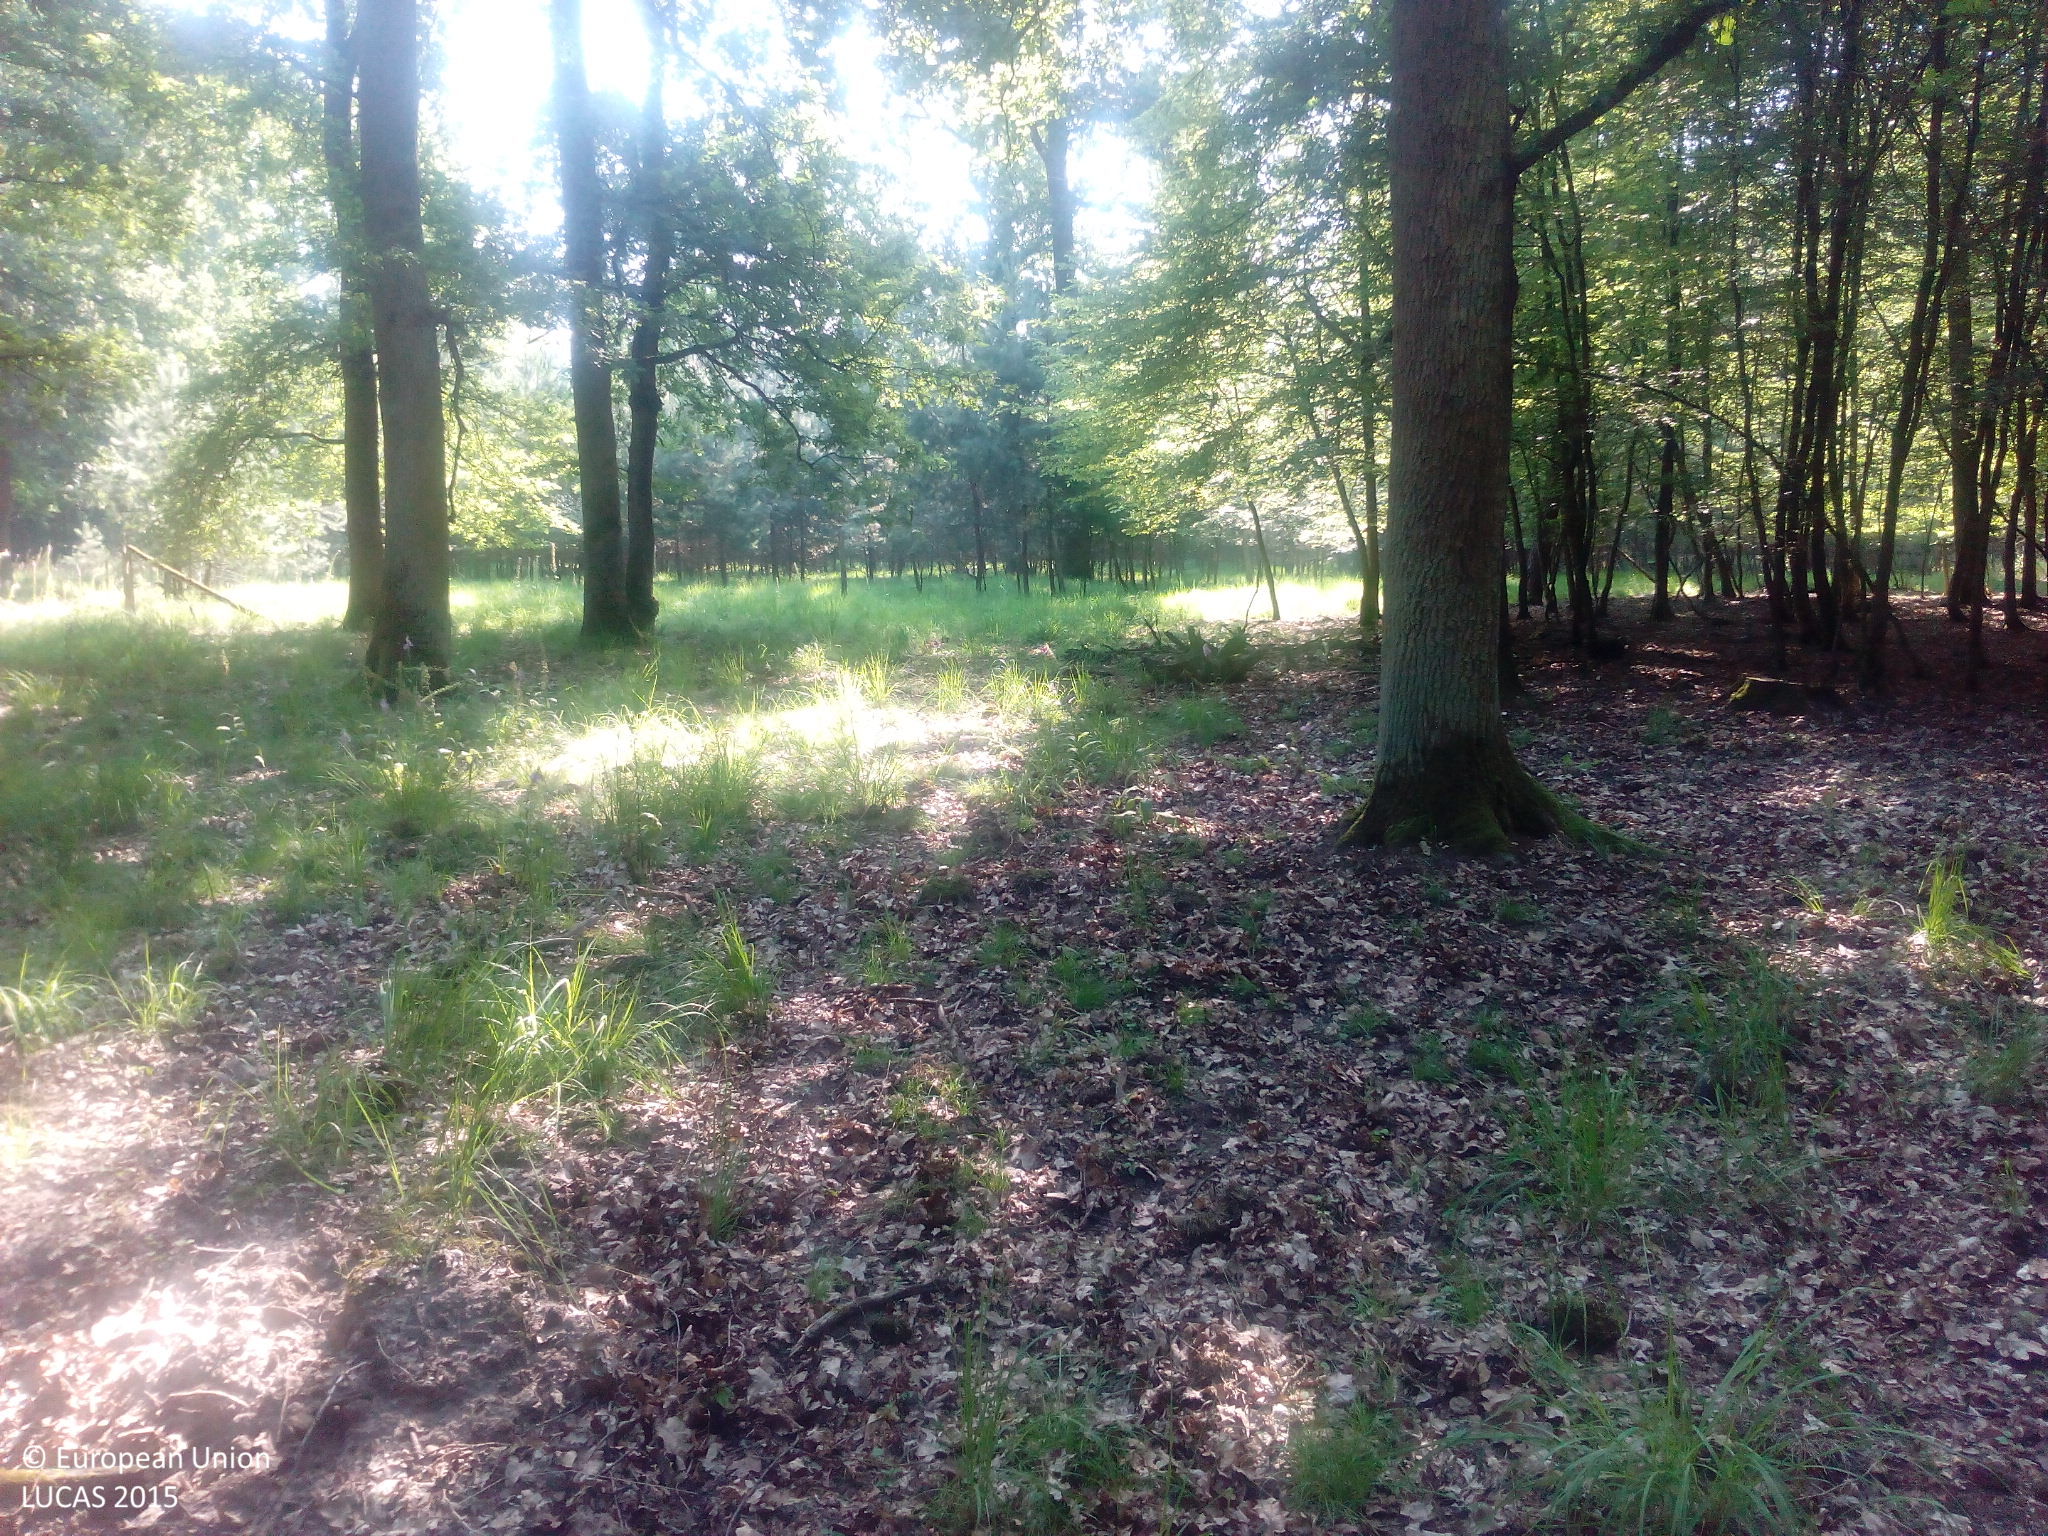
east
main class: Woodland
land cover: Broadleaved woodland
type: beech forest
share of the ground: 50 - 75 %
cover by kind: broadleaved forest trees 55 %, unconsolidated bare surface 35 %, herbaceous plants 10 %
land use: Forestry
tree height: > 5 m
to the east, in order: Broadleaved woodland; Pine dominated mixed woodland; Broadleaved woodland
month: July
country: DE
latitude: 49.9946
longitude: 8.5078
